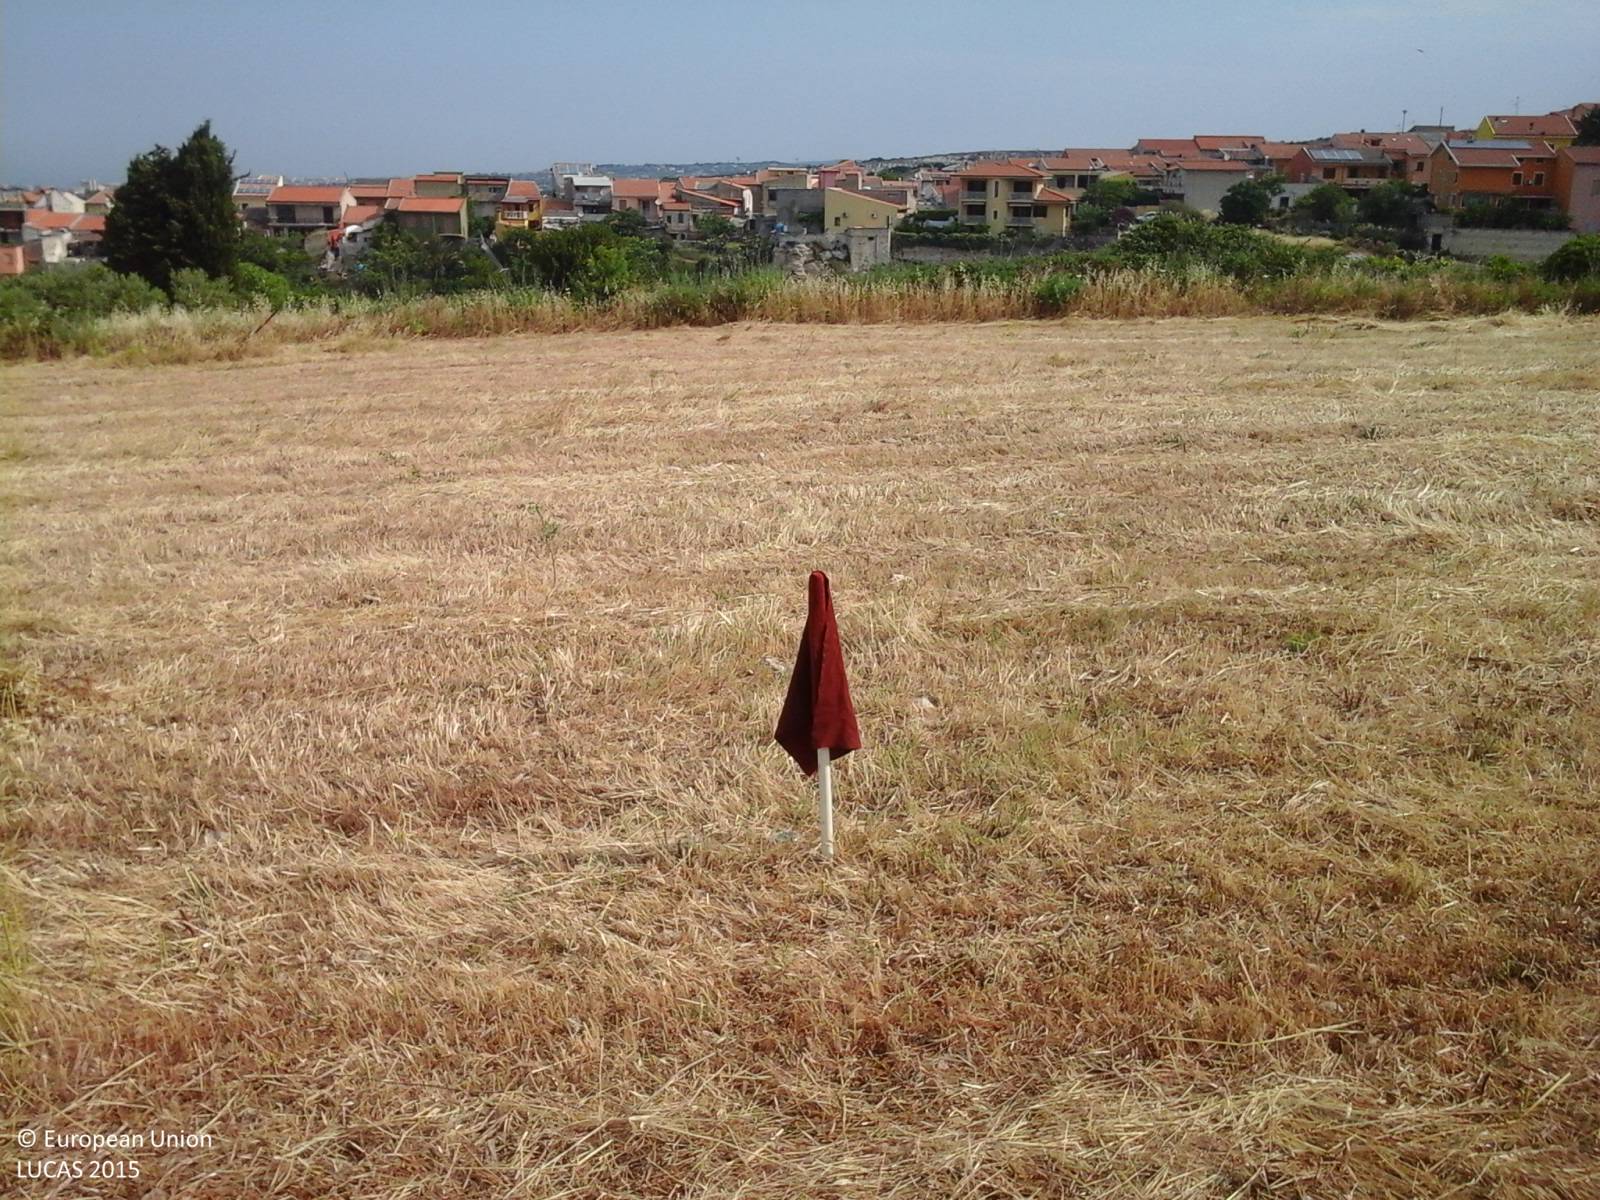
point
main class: Grassland
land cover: Grassland without tree/shrub cover
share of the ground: > 75 %
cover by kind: herbaceous plants 100 %
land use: Agriculture (excluding fallow land and kitchen gardens)
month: June
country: IT
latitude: 40.6737
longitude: 8.5990
